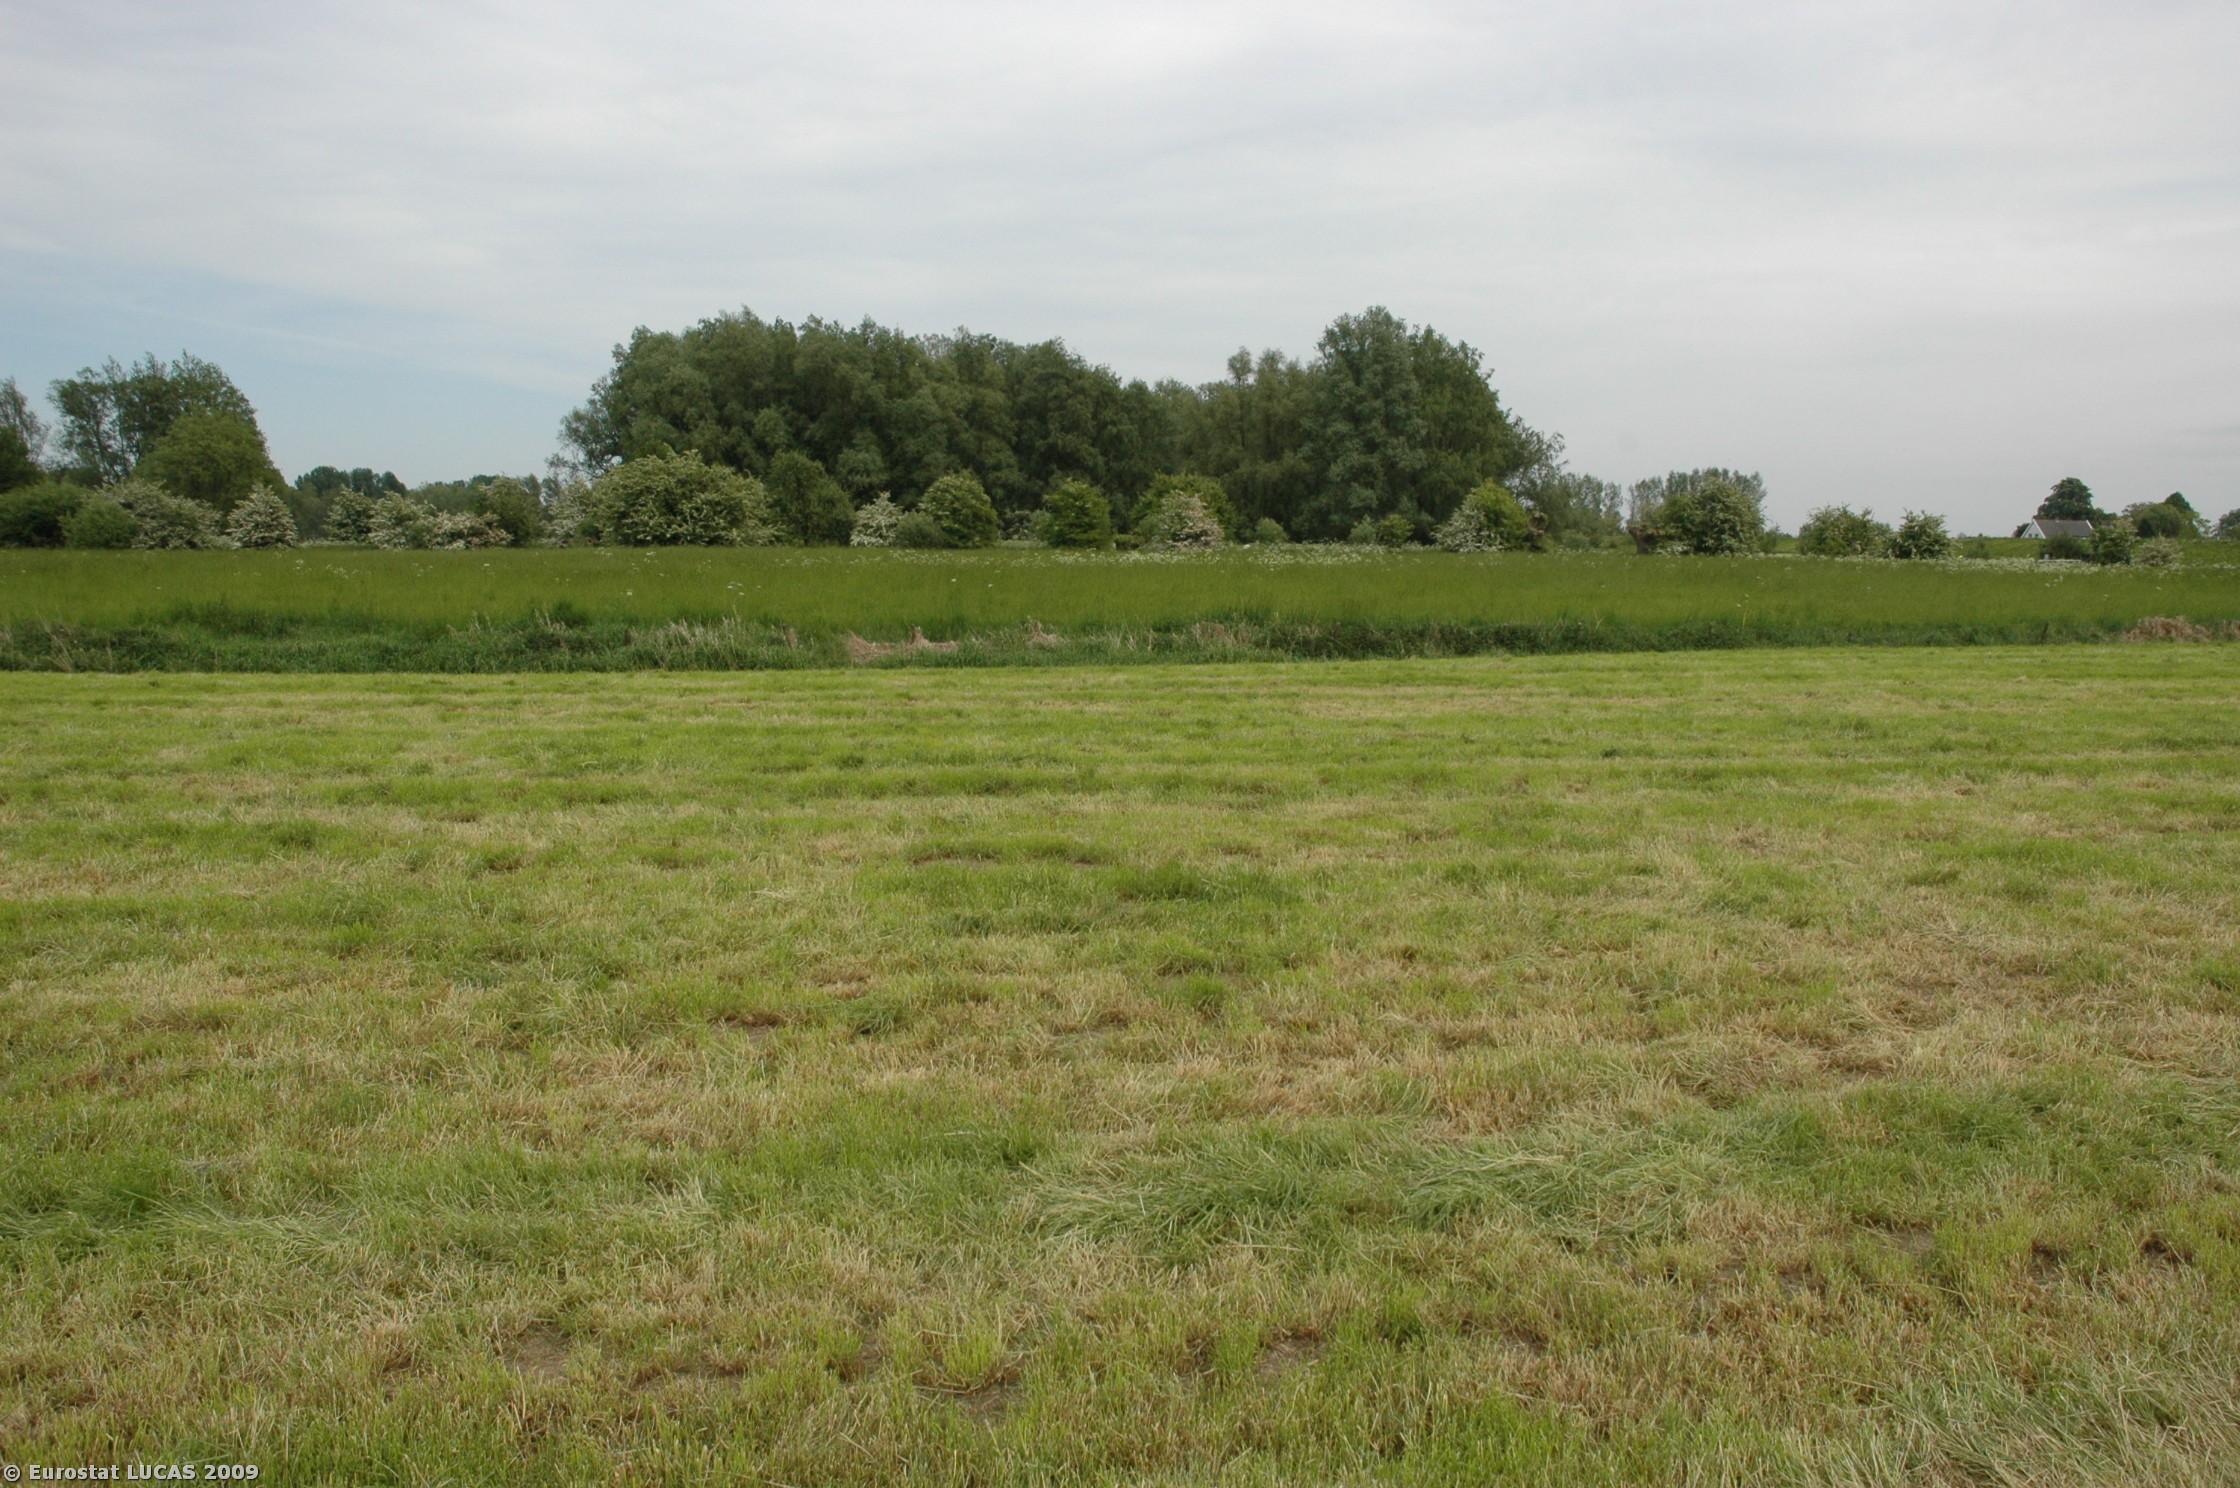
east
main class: Grassland
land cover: Grassland without tree/shrub cover
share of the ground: > 75 %
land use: Agriculture (excluding fallow land and kitchen gardens)
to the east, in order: Grassland without tree/shrub cover; Fences; Grassland without tree/shrub cover; Fences; Grassland without tree/shrub cover; Fences; Grassland without tree/shrub cover; Ditches and canals; Broadleaved woodland; Paved roads, cycling and walking lanes; Broadleaved woodland; Ditches and canals; Broadleaved woodland; Grassland without tree/shrub cover; Broadleaved woodland
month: May
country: NL
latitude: 51.9626
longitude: 5.3554
